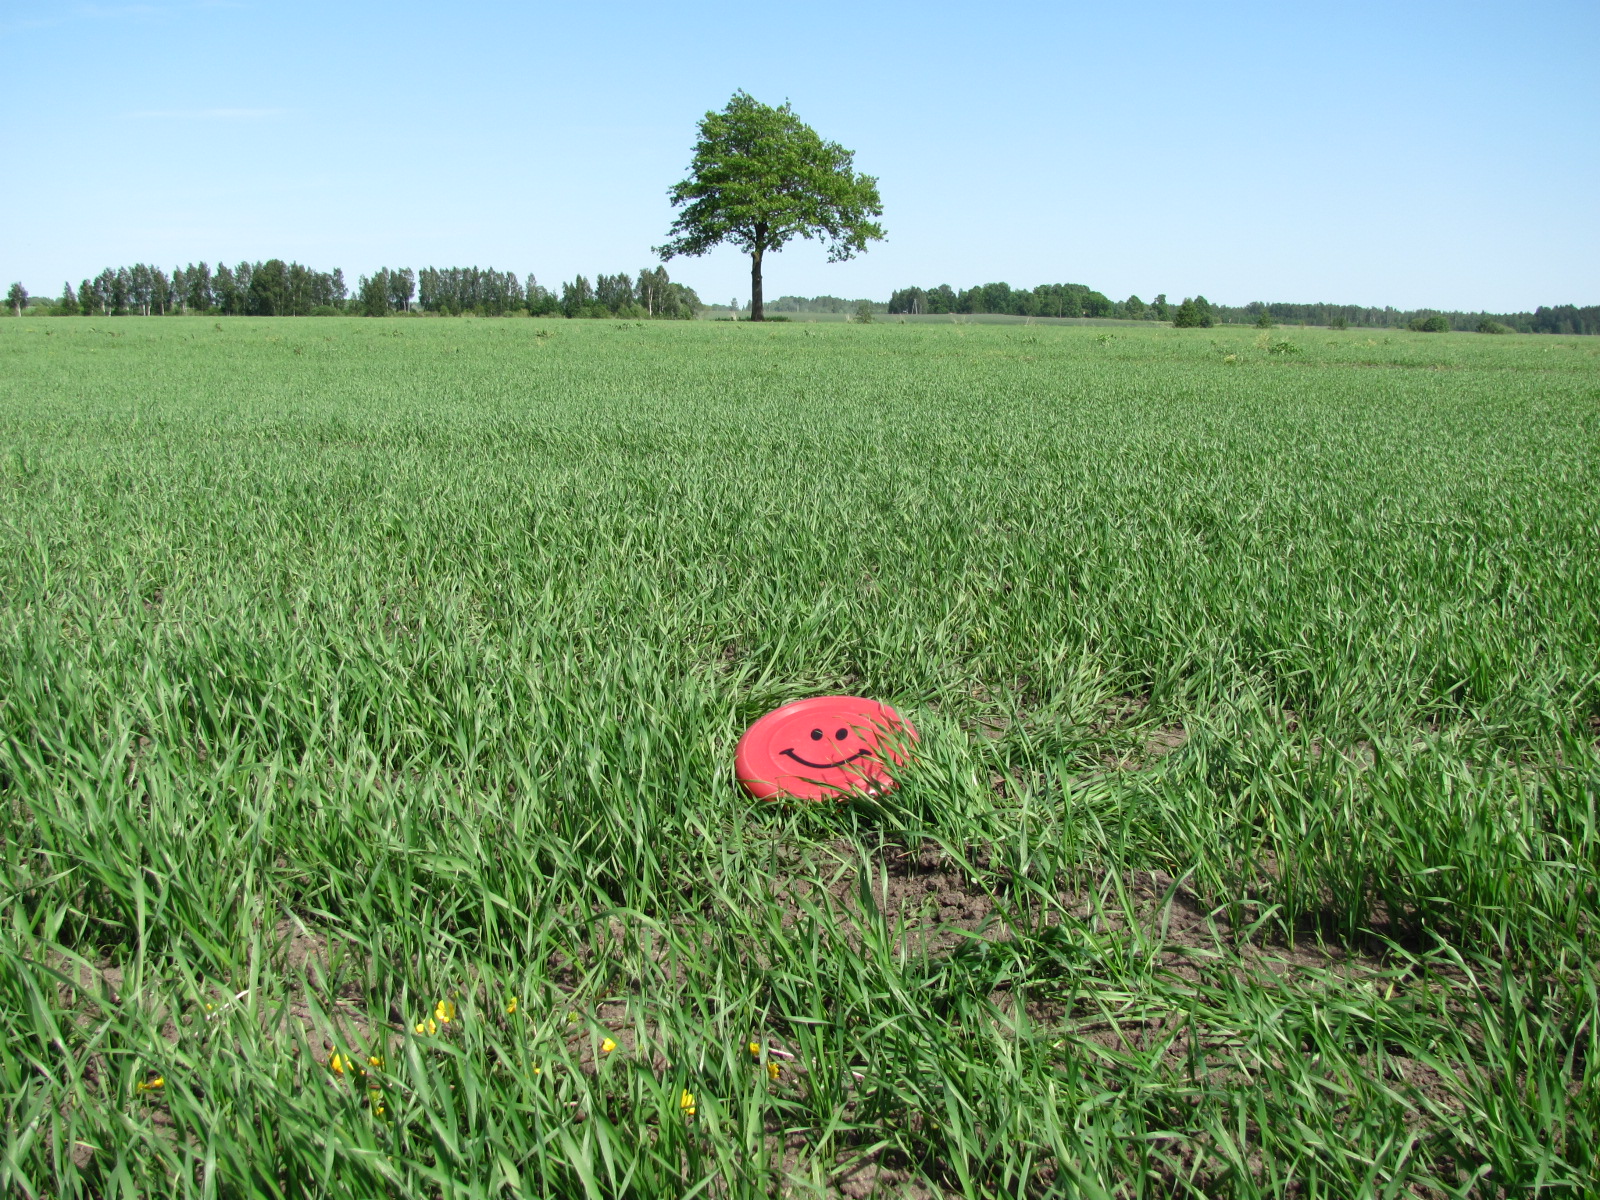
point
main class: Cropland
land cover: Common wheat
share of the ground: > 75 %
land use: Agriculture (excluding fallow land and kitchen gardens)
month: June
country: LV
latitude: 56.4930
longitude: 24.3369
